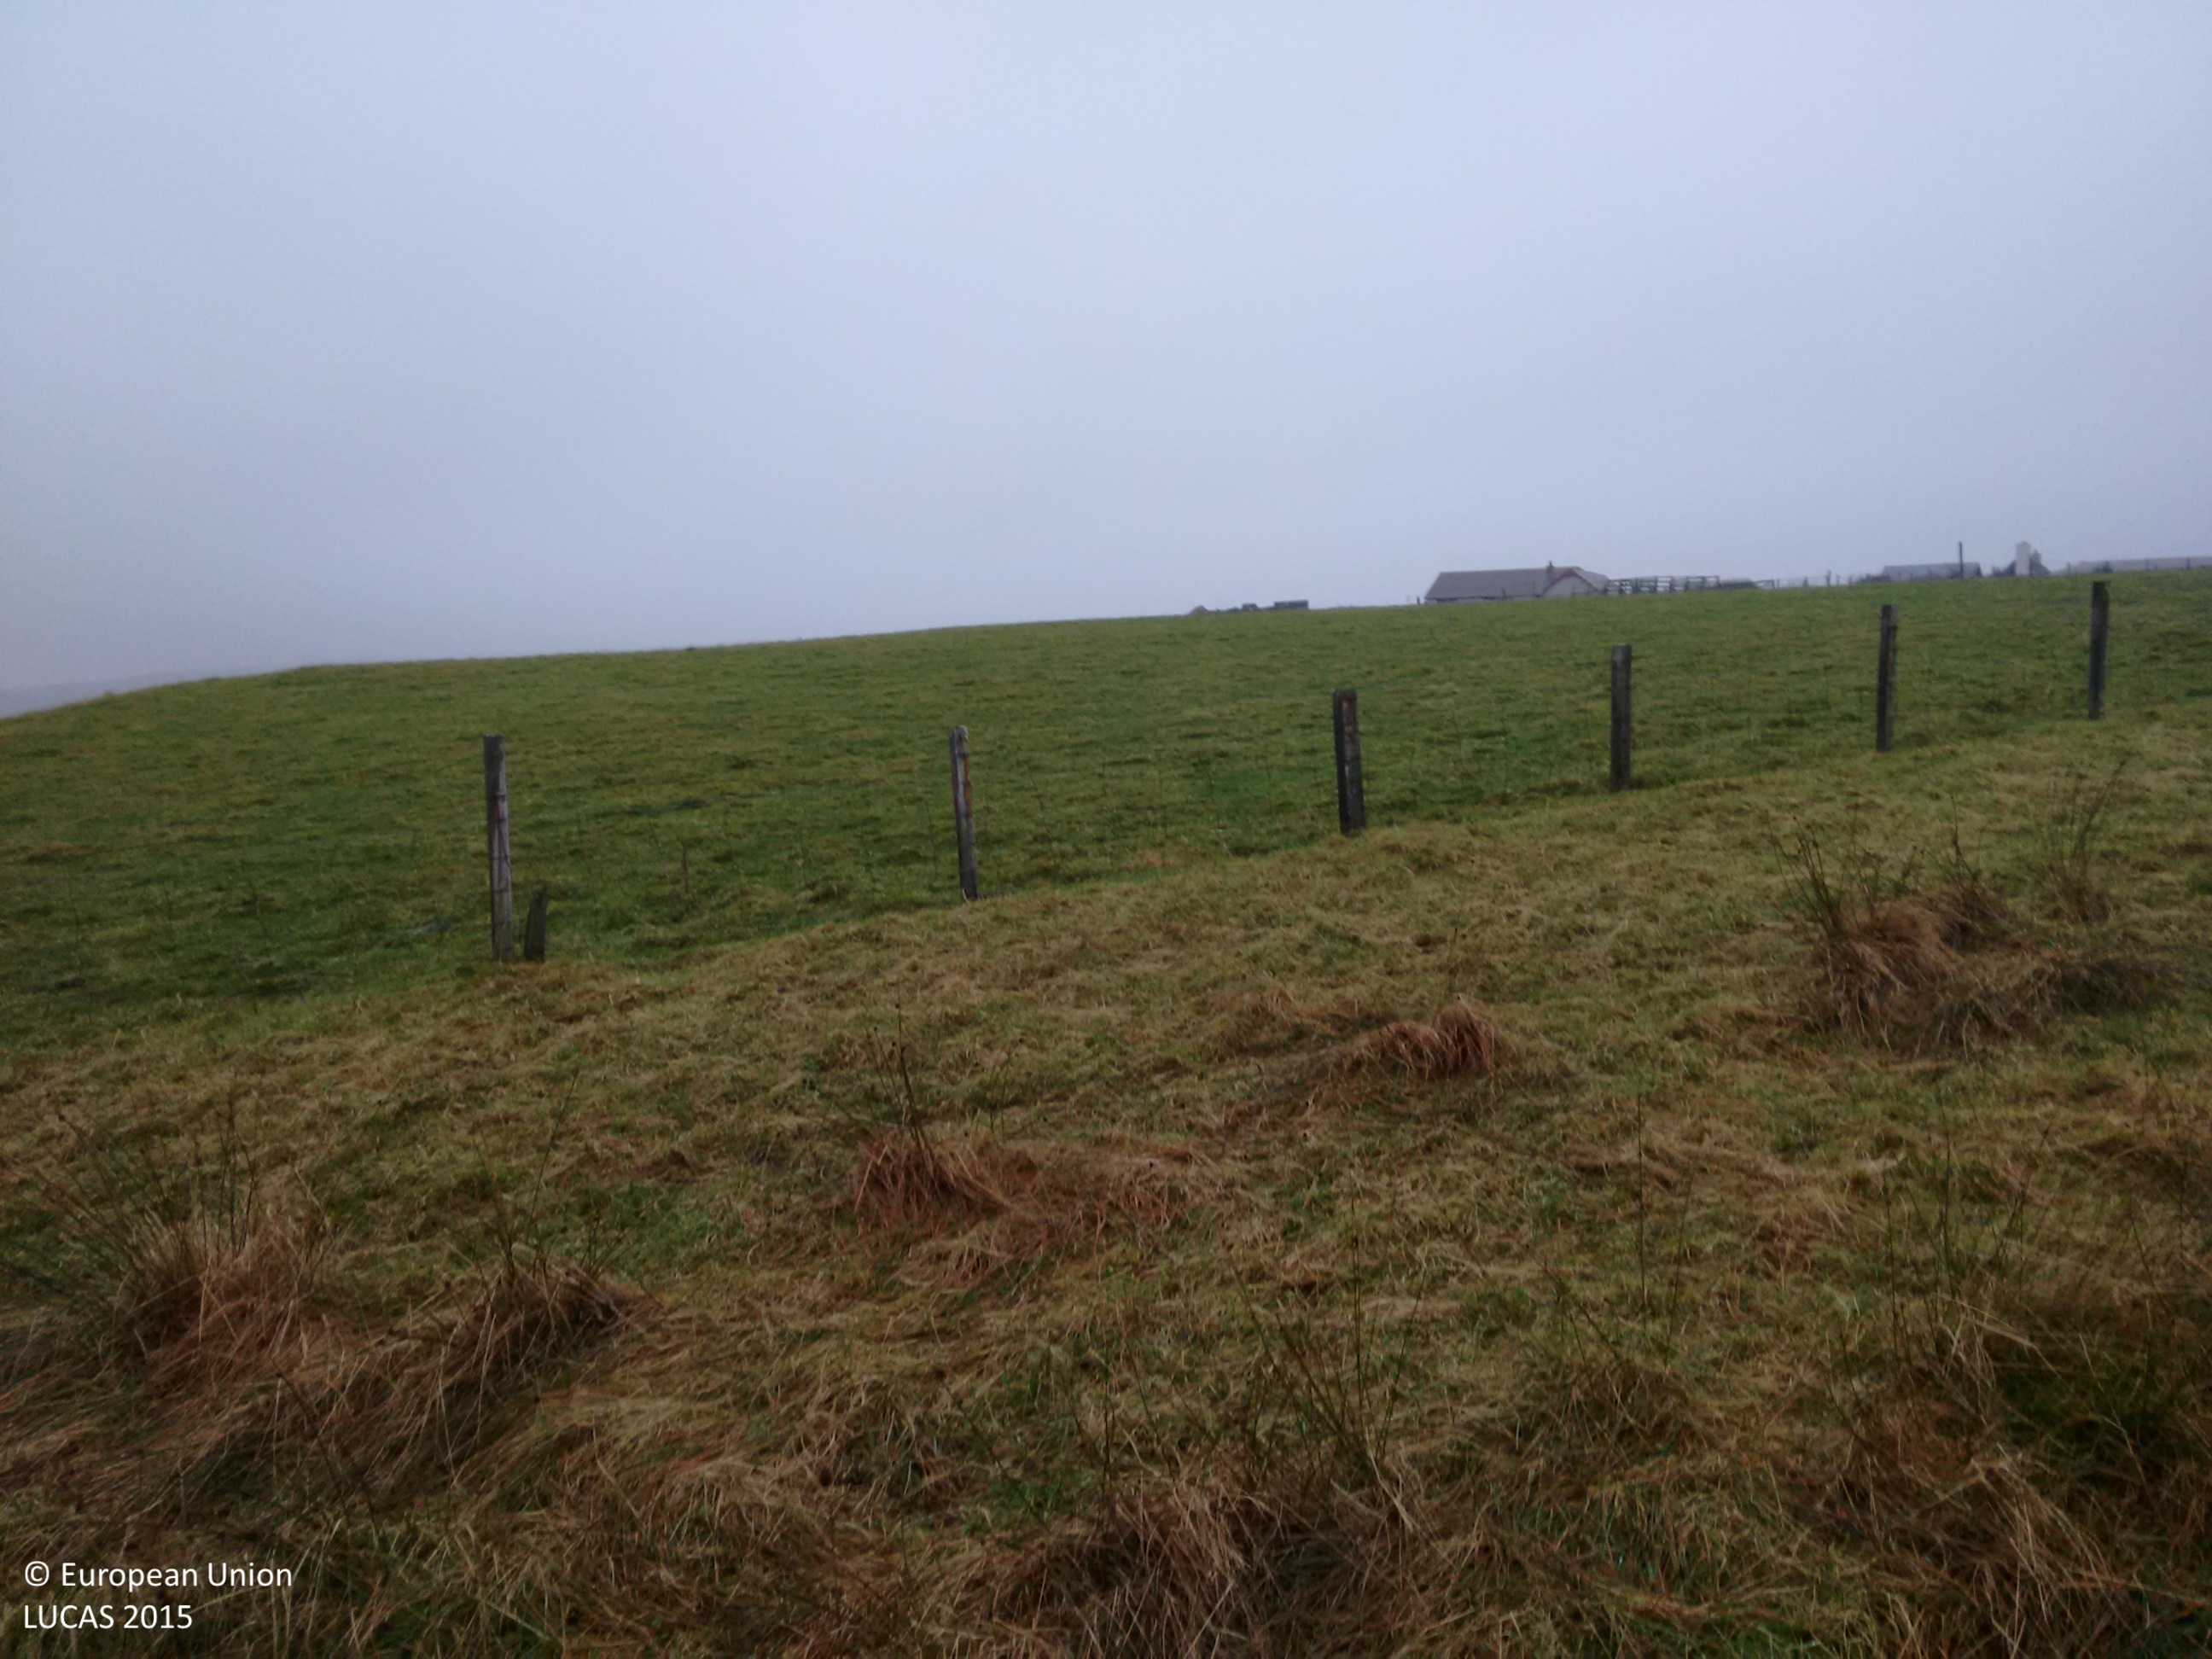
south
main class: Grassland
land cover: Grassland without tree/shrub cover
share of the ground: > 75 %
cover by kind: herbaceous plants 100 %
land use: Agriculture (excluding fallow land and kitchen gardens)
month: November
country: GB
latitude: 60.4793
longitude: -1.2062
